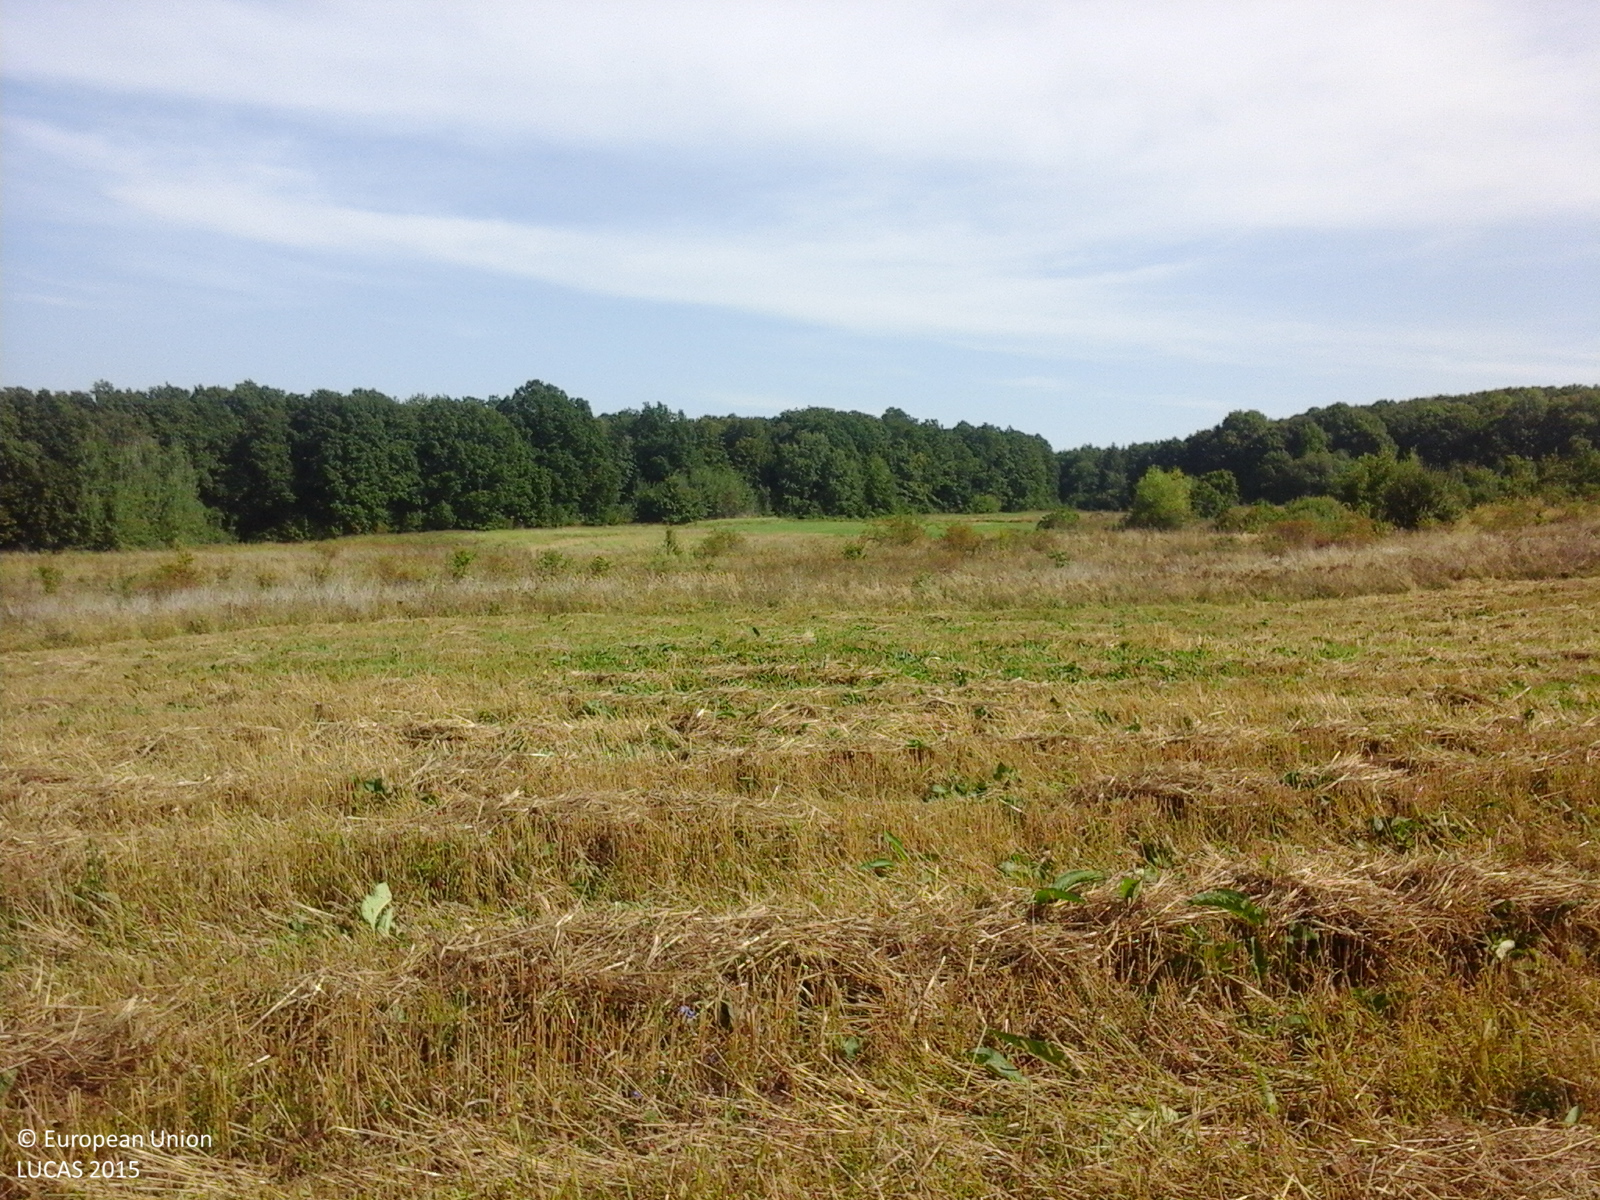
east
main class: Cropland
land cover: Maize
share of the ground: > 75 %
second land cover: Spontaneously vegetated surfaces
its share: 25 - 50 %
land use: Agriculture (excluding fallow land and kitchen gardens)
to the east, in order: Maize; Spontaneously vegetated surfaces; Common wheat; Spontaneously vegetated surfaces; Tracks; Spontaneously vegetated surfaces
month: September
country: RO
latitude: 46.8653
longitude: 23.5967
